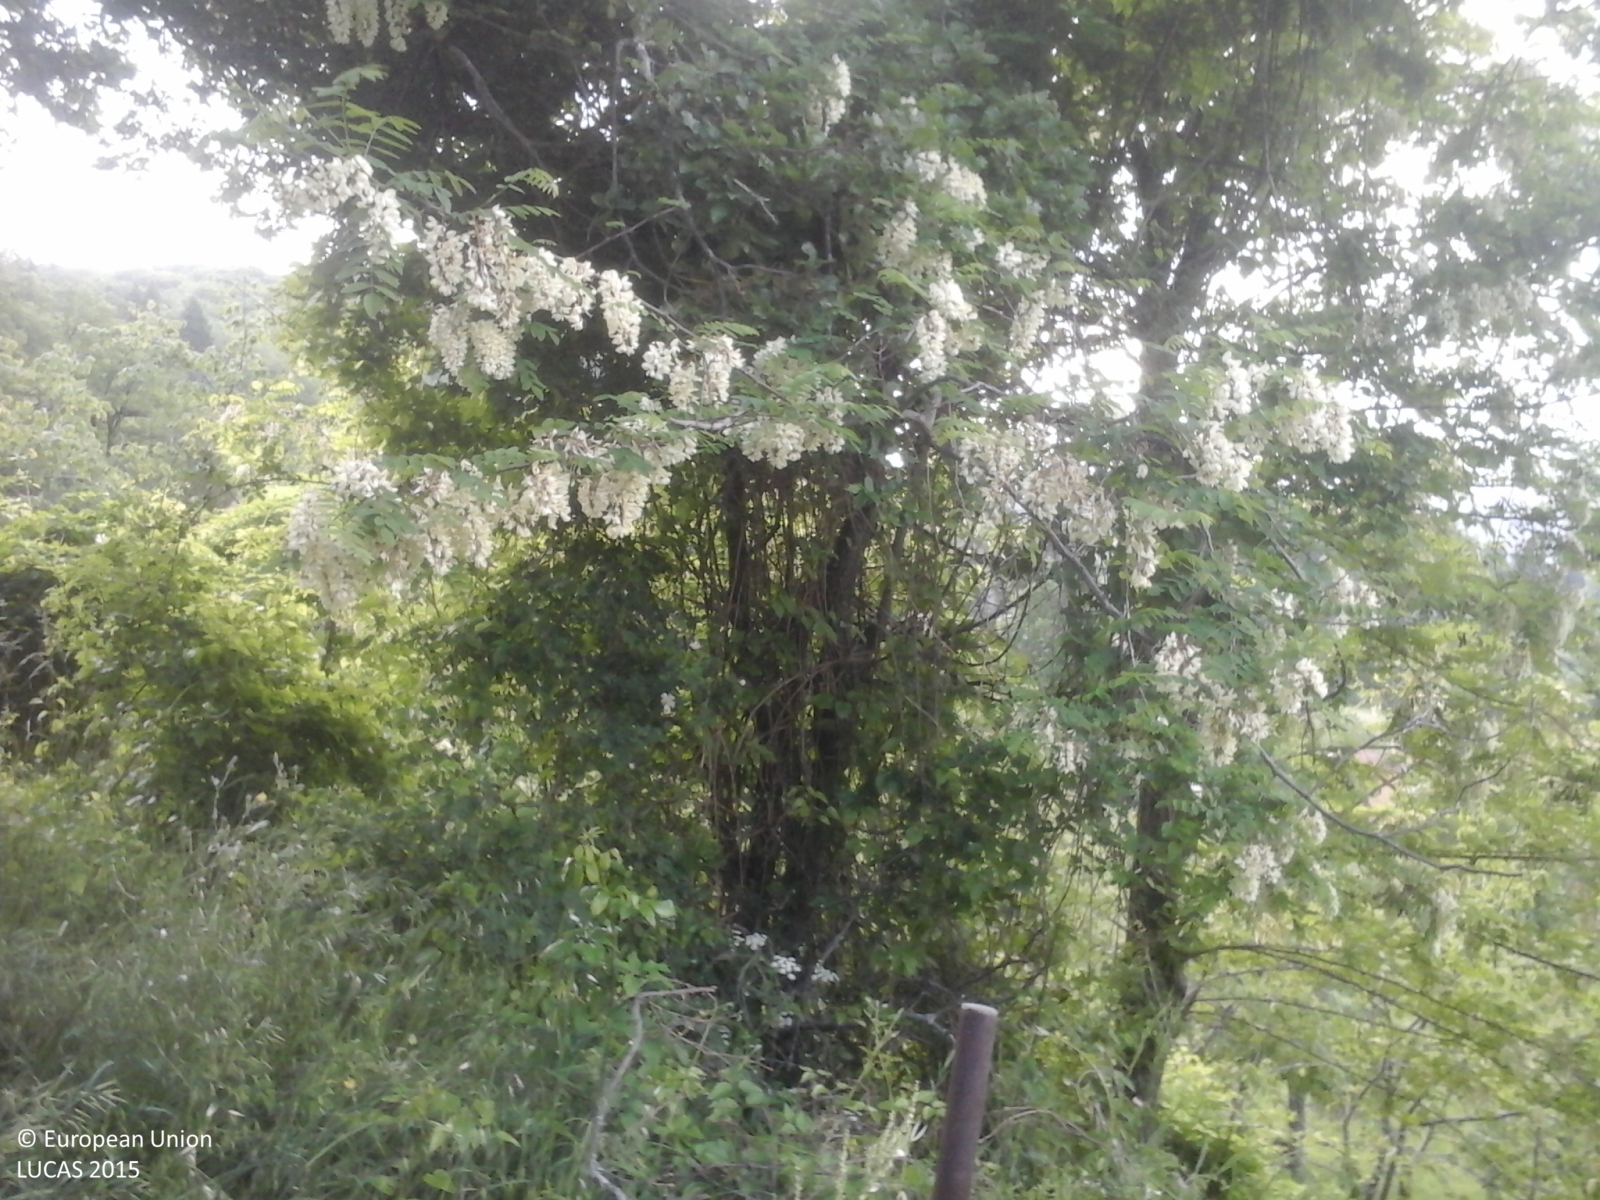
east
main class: Woodland
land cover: Broadleaved woodland
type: thermophilous deciduous forest
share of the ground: > 75 %
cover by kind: broadleaved forest trees 90 %, shrubs 10 %
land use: Forestry
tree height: > 5 m
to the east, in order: Broadleaved woodland
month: May
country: IT
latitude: 44.3090
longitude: 11.0631
